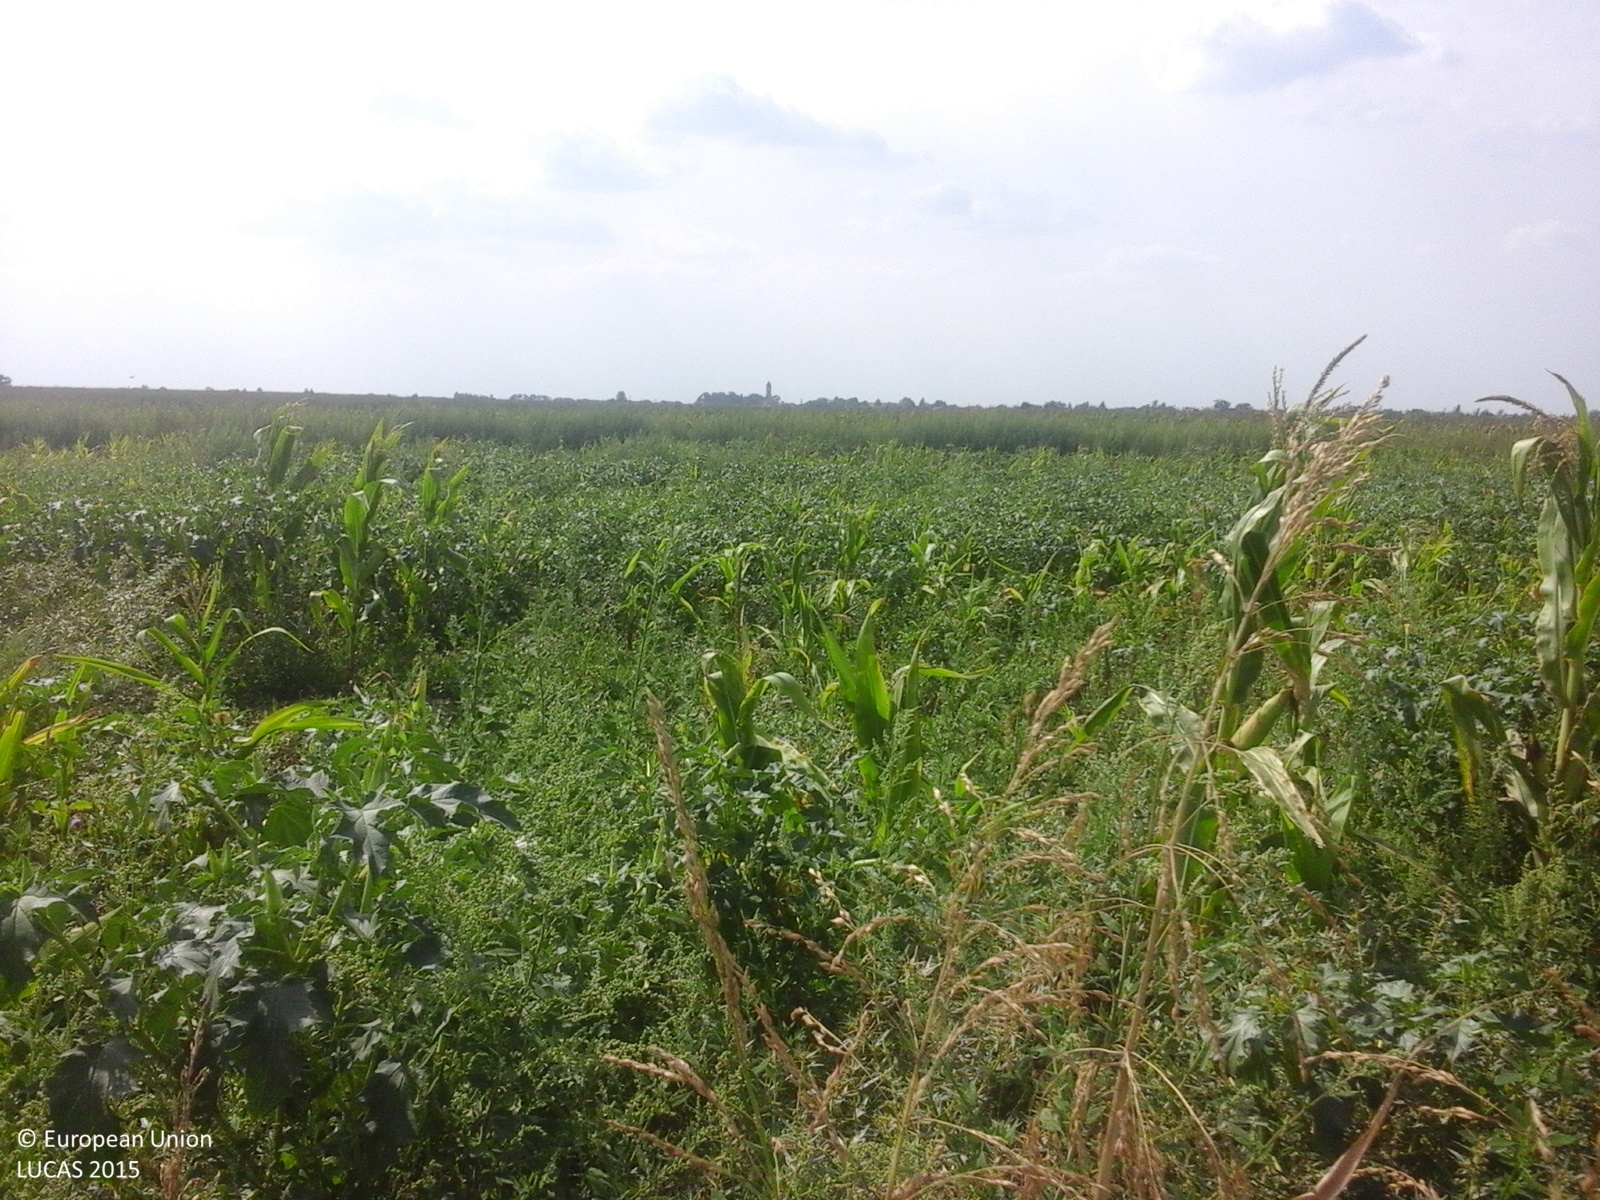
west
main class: Grassland
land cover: Spontaneously vegetated surfaces
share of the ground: > 75 %
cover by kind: herbaceous plants 100 %
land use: Fallow land
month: August
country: RO
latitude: 46.4158
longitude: 21.3676
